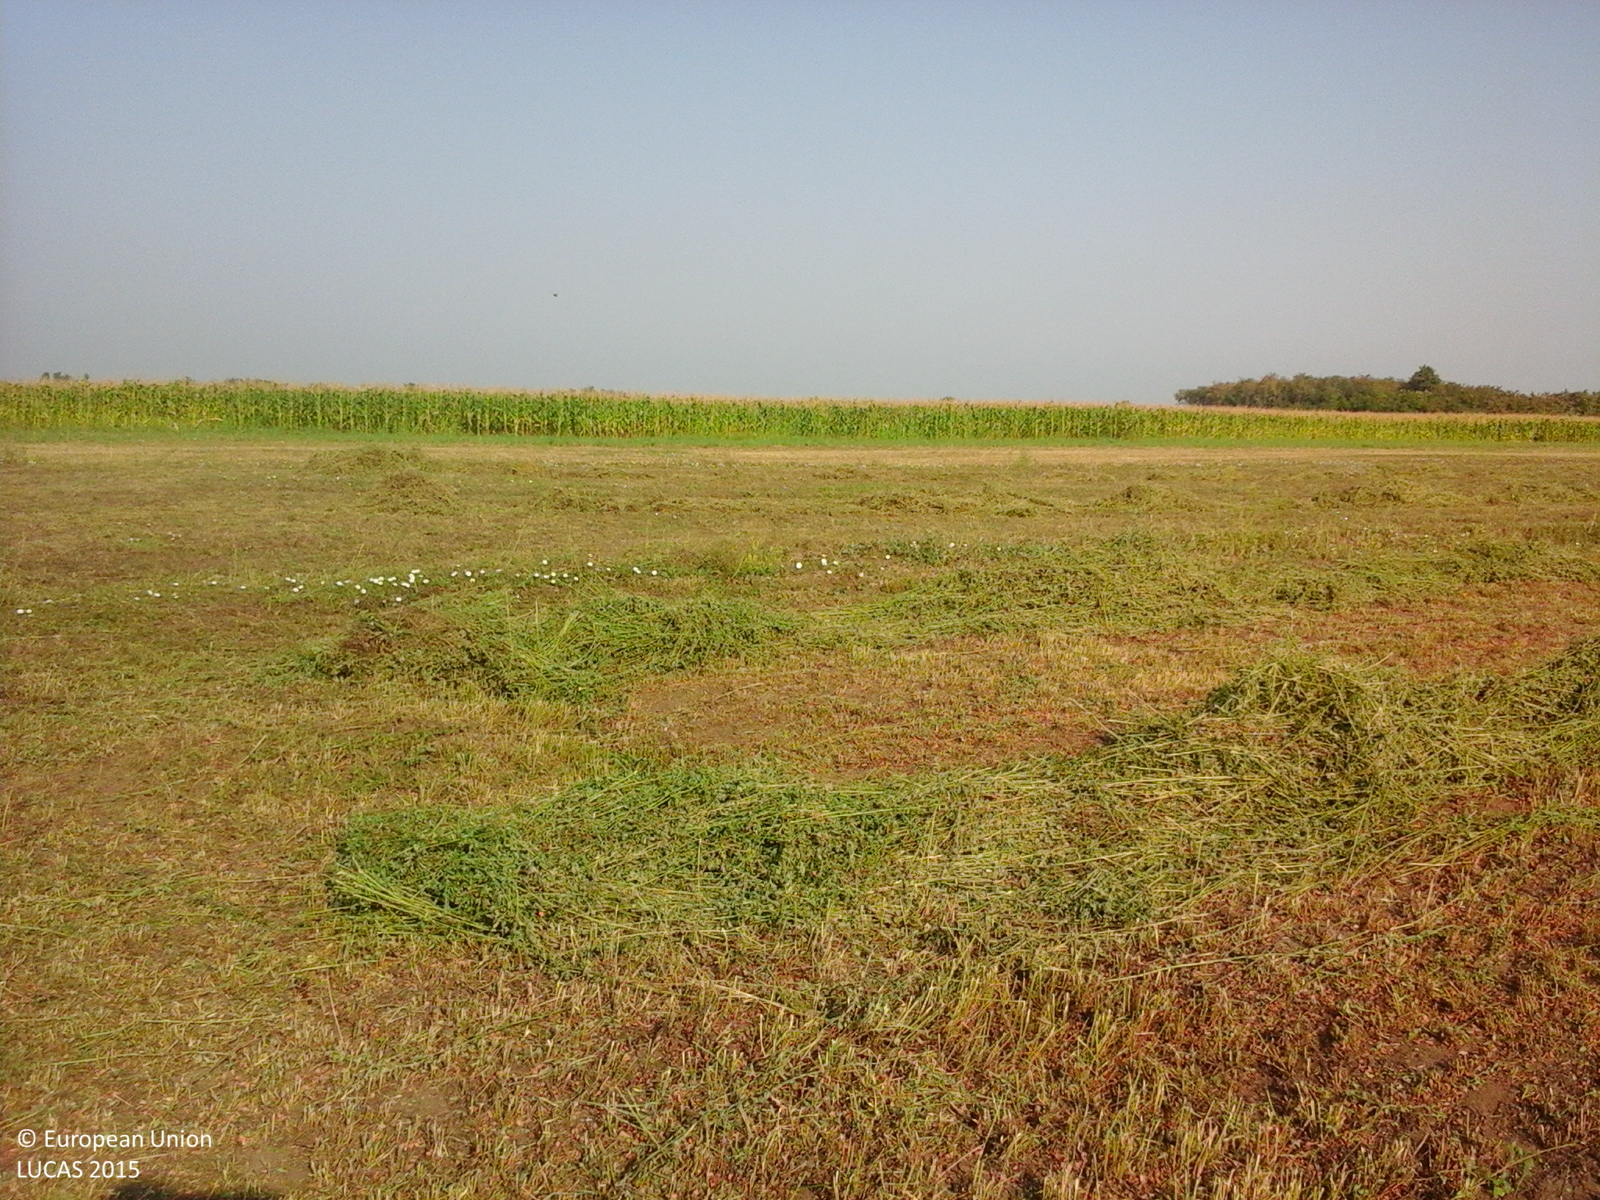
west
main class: Cropland
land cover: Lucerne
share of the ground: 50 - 75 %
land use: Agriculture (excluding fallow land and kitchen gardens)
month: July
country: RO
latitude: 45.5681
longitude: 27.5429
